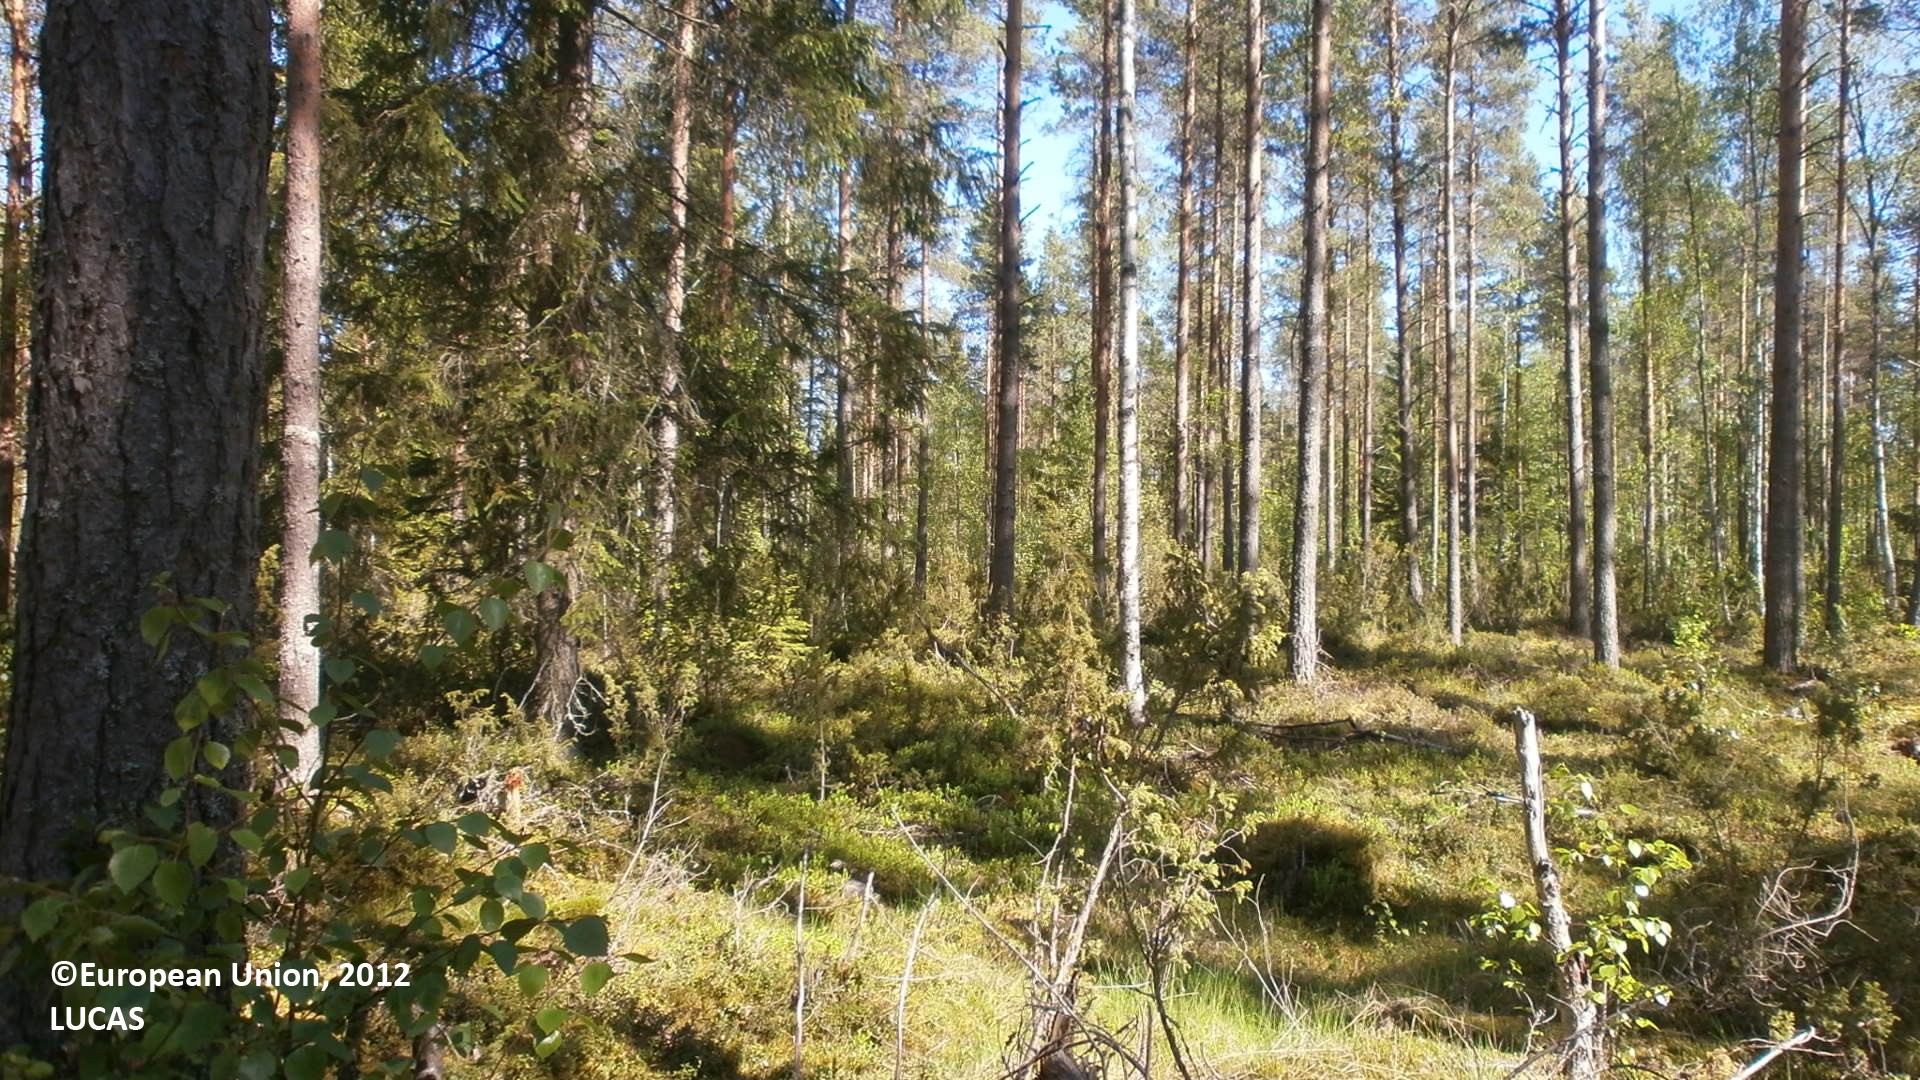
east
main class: Woodland
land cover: Pine dominated coniferous woodland
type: hemiboreal forest and nemoral coniferous forest and mixed broadleaved-coniferous forest
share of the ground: 25 - 50 %
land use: Forestry
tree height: > 5 m
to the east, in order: Pine dominated coniferous woodland; Ditches and canals; Pine dominated mixed woodland; Other mixed woodland; Shruby margins; Ditches and canals; Shrubland with sparse tree cover; Grassland without tree/shrub cover; Paved roads, cycling and walking lanes; Grassland without tree/shrub cover; Ditches and canals; Shrubland with sparse tree cover; Pine dominated coniferous woodland; Ditches and canals; Pine dominated coniferous woodland; Ditches and canals; Pine dominated mixed woodland
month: June
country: FI
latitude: 64.1728
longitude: 25.7980
